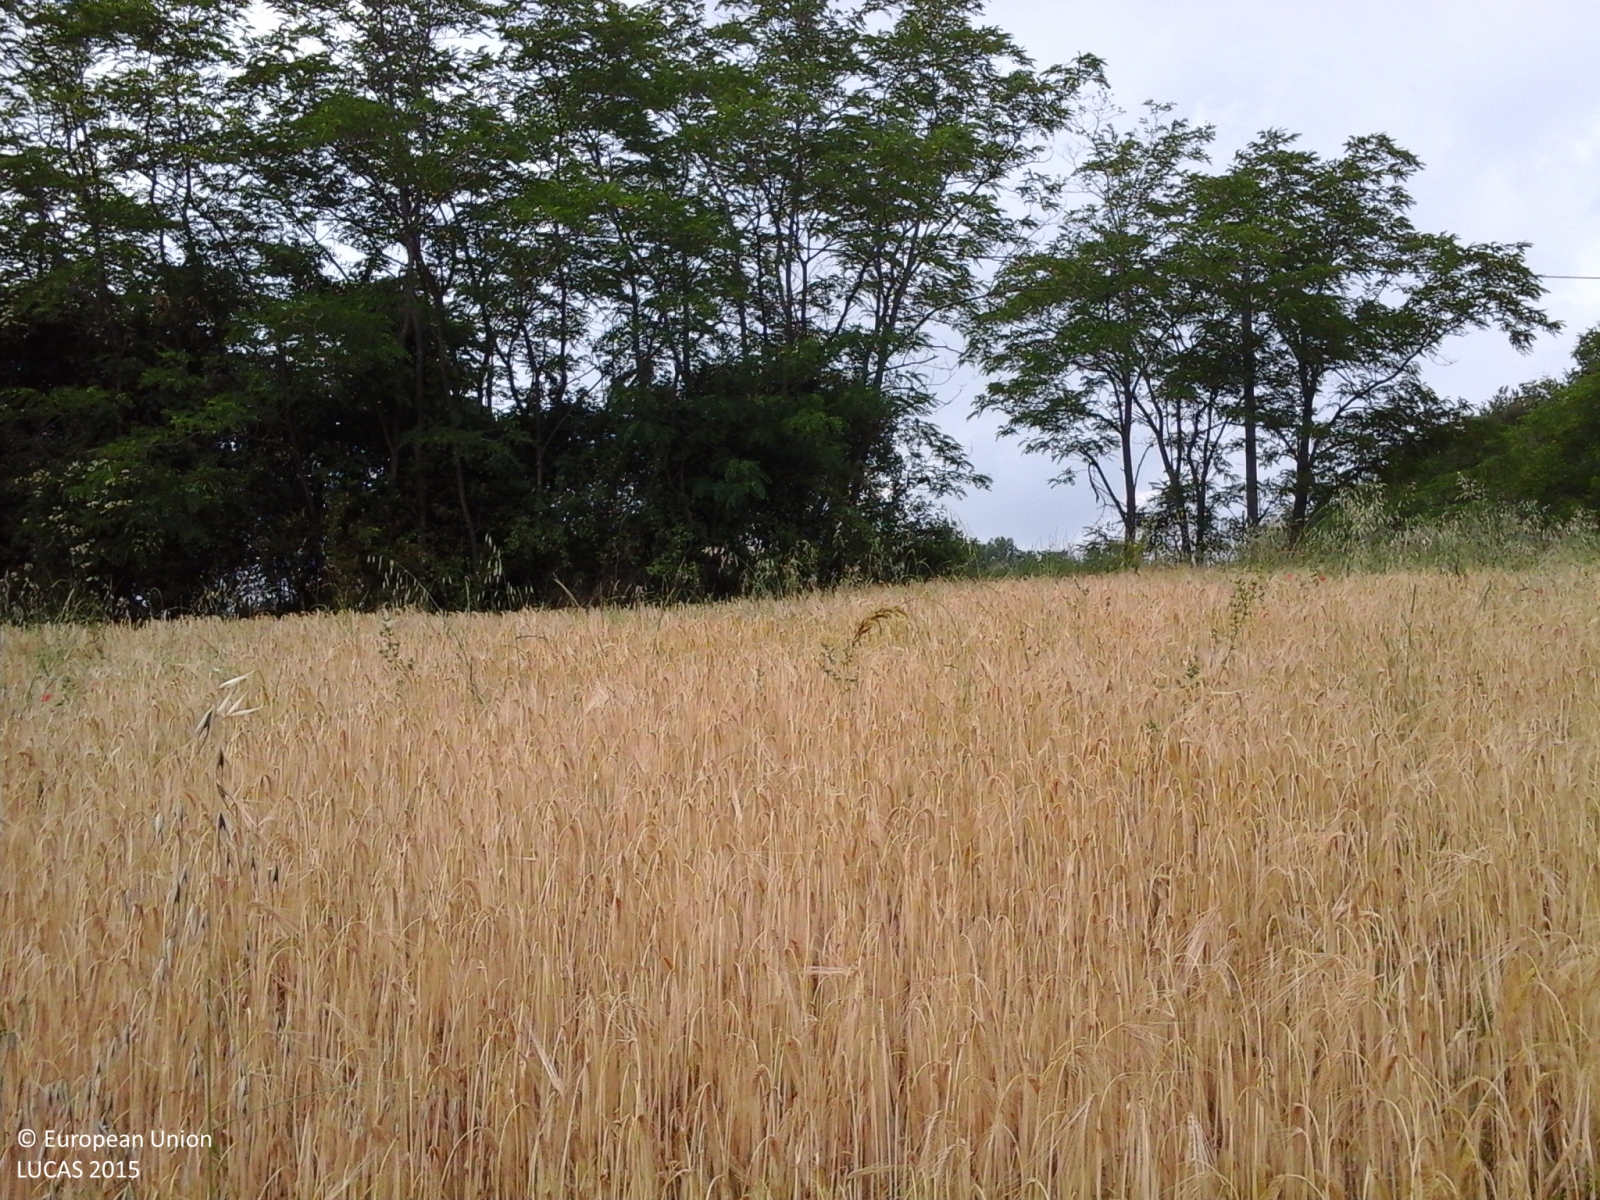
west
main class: Cropland
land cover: Barley
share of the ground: > 75 %
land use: Agriculture (excluding fallow land and kitchen gardens)
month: June
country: IT
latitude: 44.8369
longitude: 9.6592
